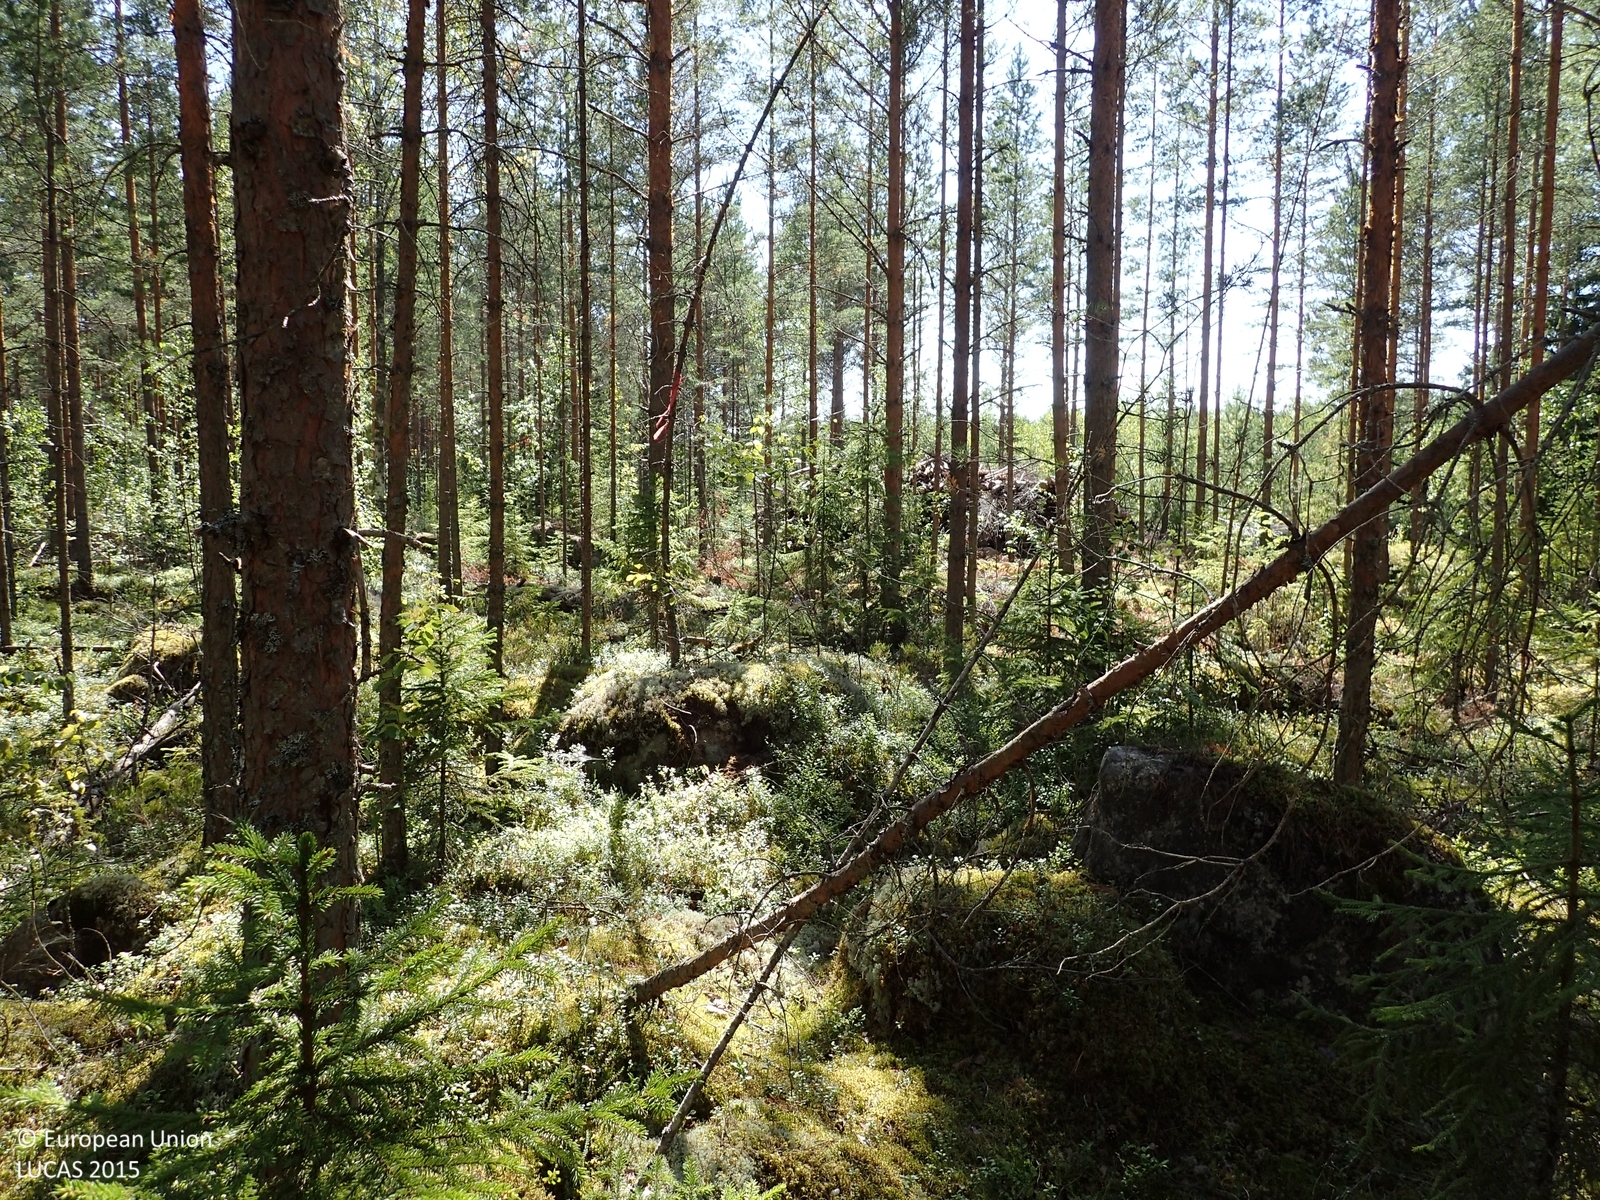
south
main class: Woodland
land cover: Pine dominated coniferous woodland
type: boreal forest
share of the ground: 50 - 75 %
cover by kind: coniferous forest trees 55 %, shrubs 25 %, lichens and mosses 15 %, broadleaved forest trees 5 %
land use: Forestry
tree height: > 5 m
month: August
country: FI
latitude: 62.5418
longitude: 22.5559
